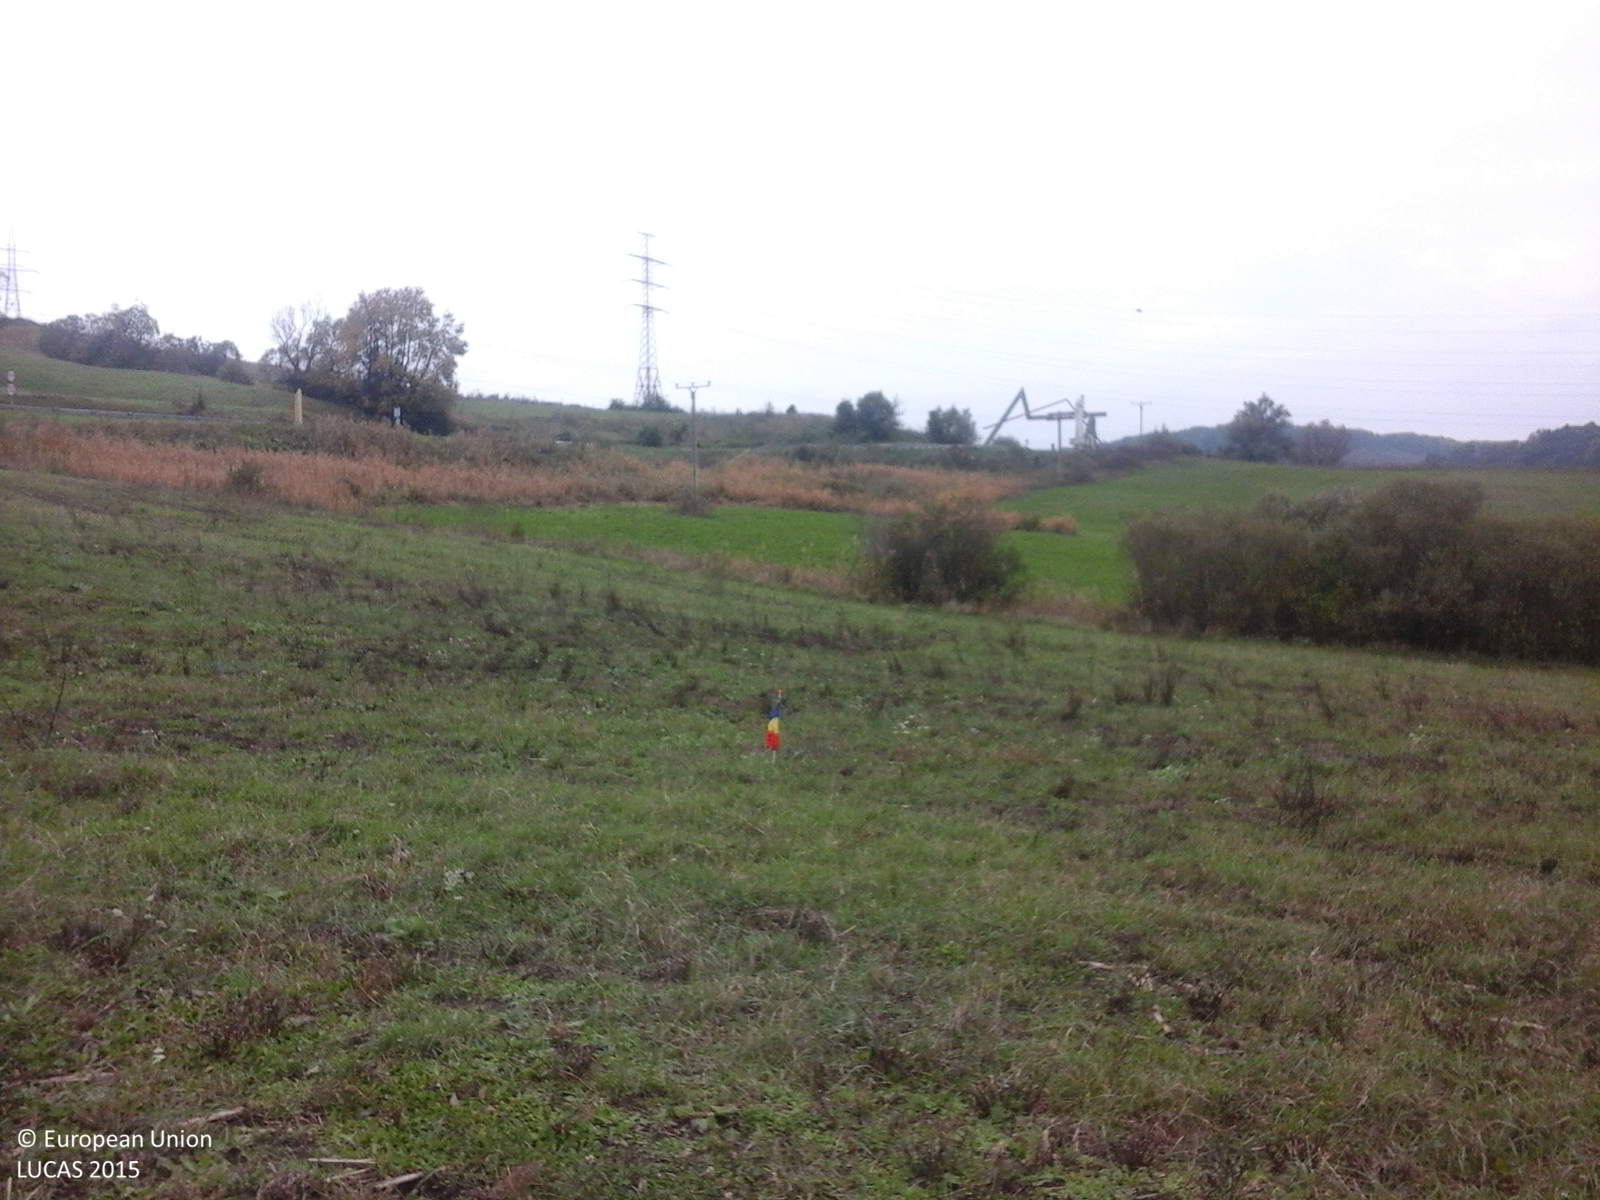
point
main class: Grassland
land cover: Grassland without tree/shrub cover
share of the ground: > 75 %
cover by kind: herbaceous plants 100 %
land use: Agriculture (excluding fallow land and kitchen gardens)
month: October
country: RO
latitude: 46.1433
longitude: 25.0219
